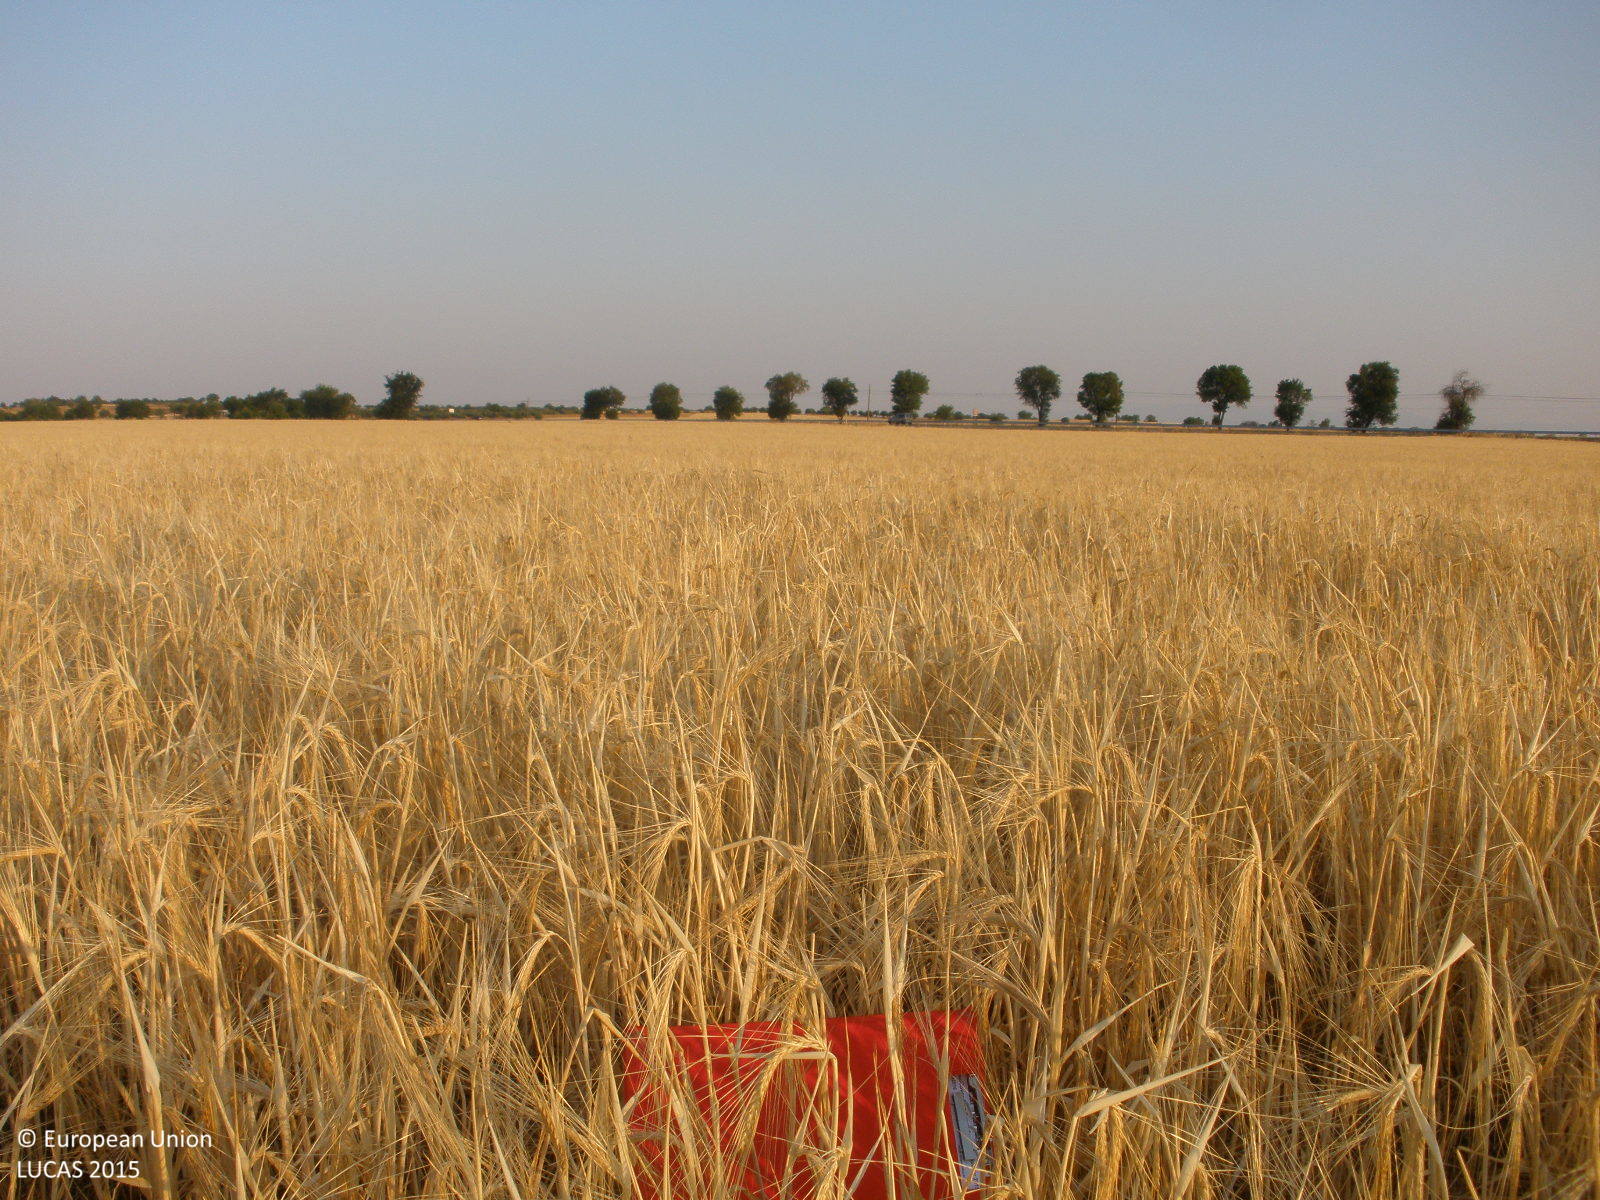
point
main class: Cropland
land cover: Barley
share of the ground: > 75 %
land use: Agriculture (excluding fallow land and kitchen gardens)
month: June
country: ES
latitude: 40.3397
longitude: -3.3459
